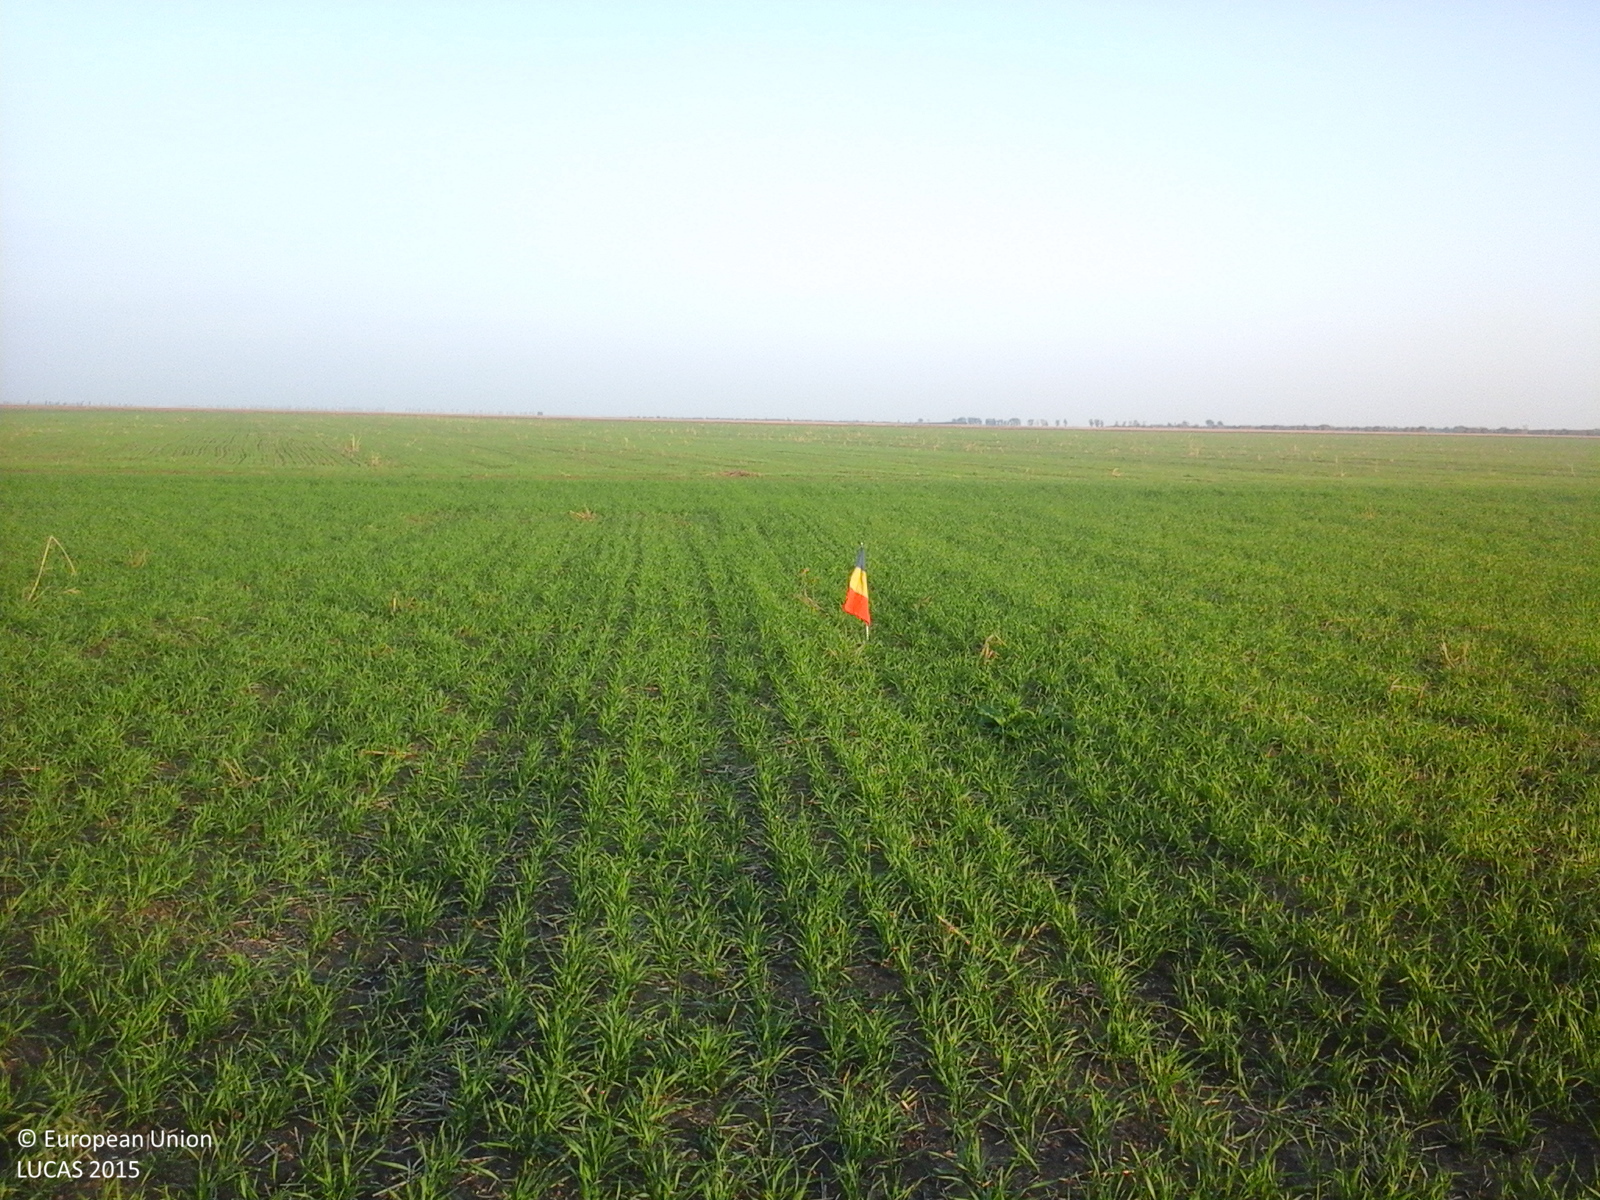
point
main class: Cropland
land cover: Common wheat
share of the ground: > 75 %
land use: Agriculture (excluding fallow land and kitchen gardens)
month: October
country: RO
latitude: 45.2327
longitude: 27.0141
